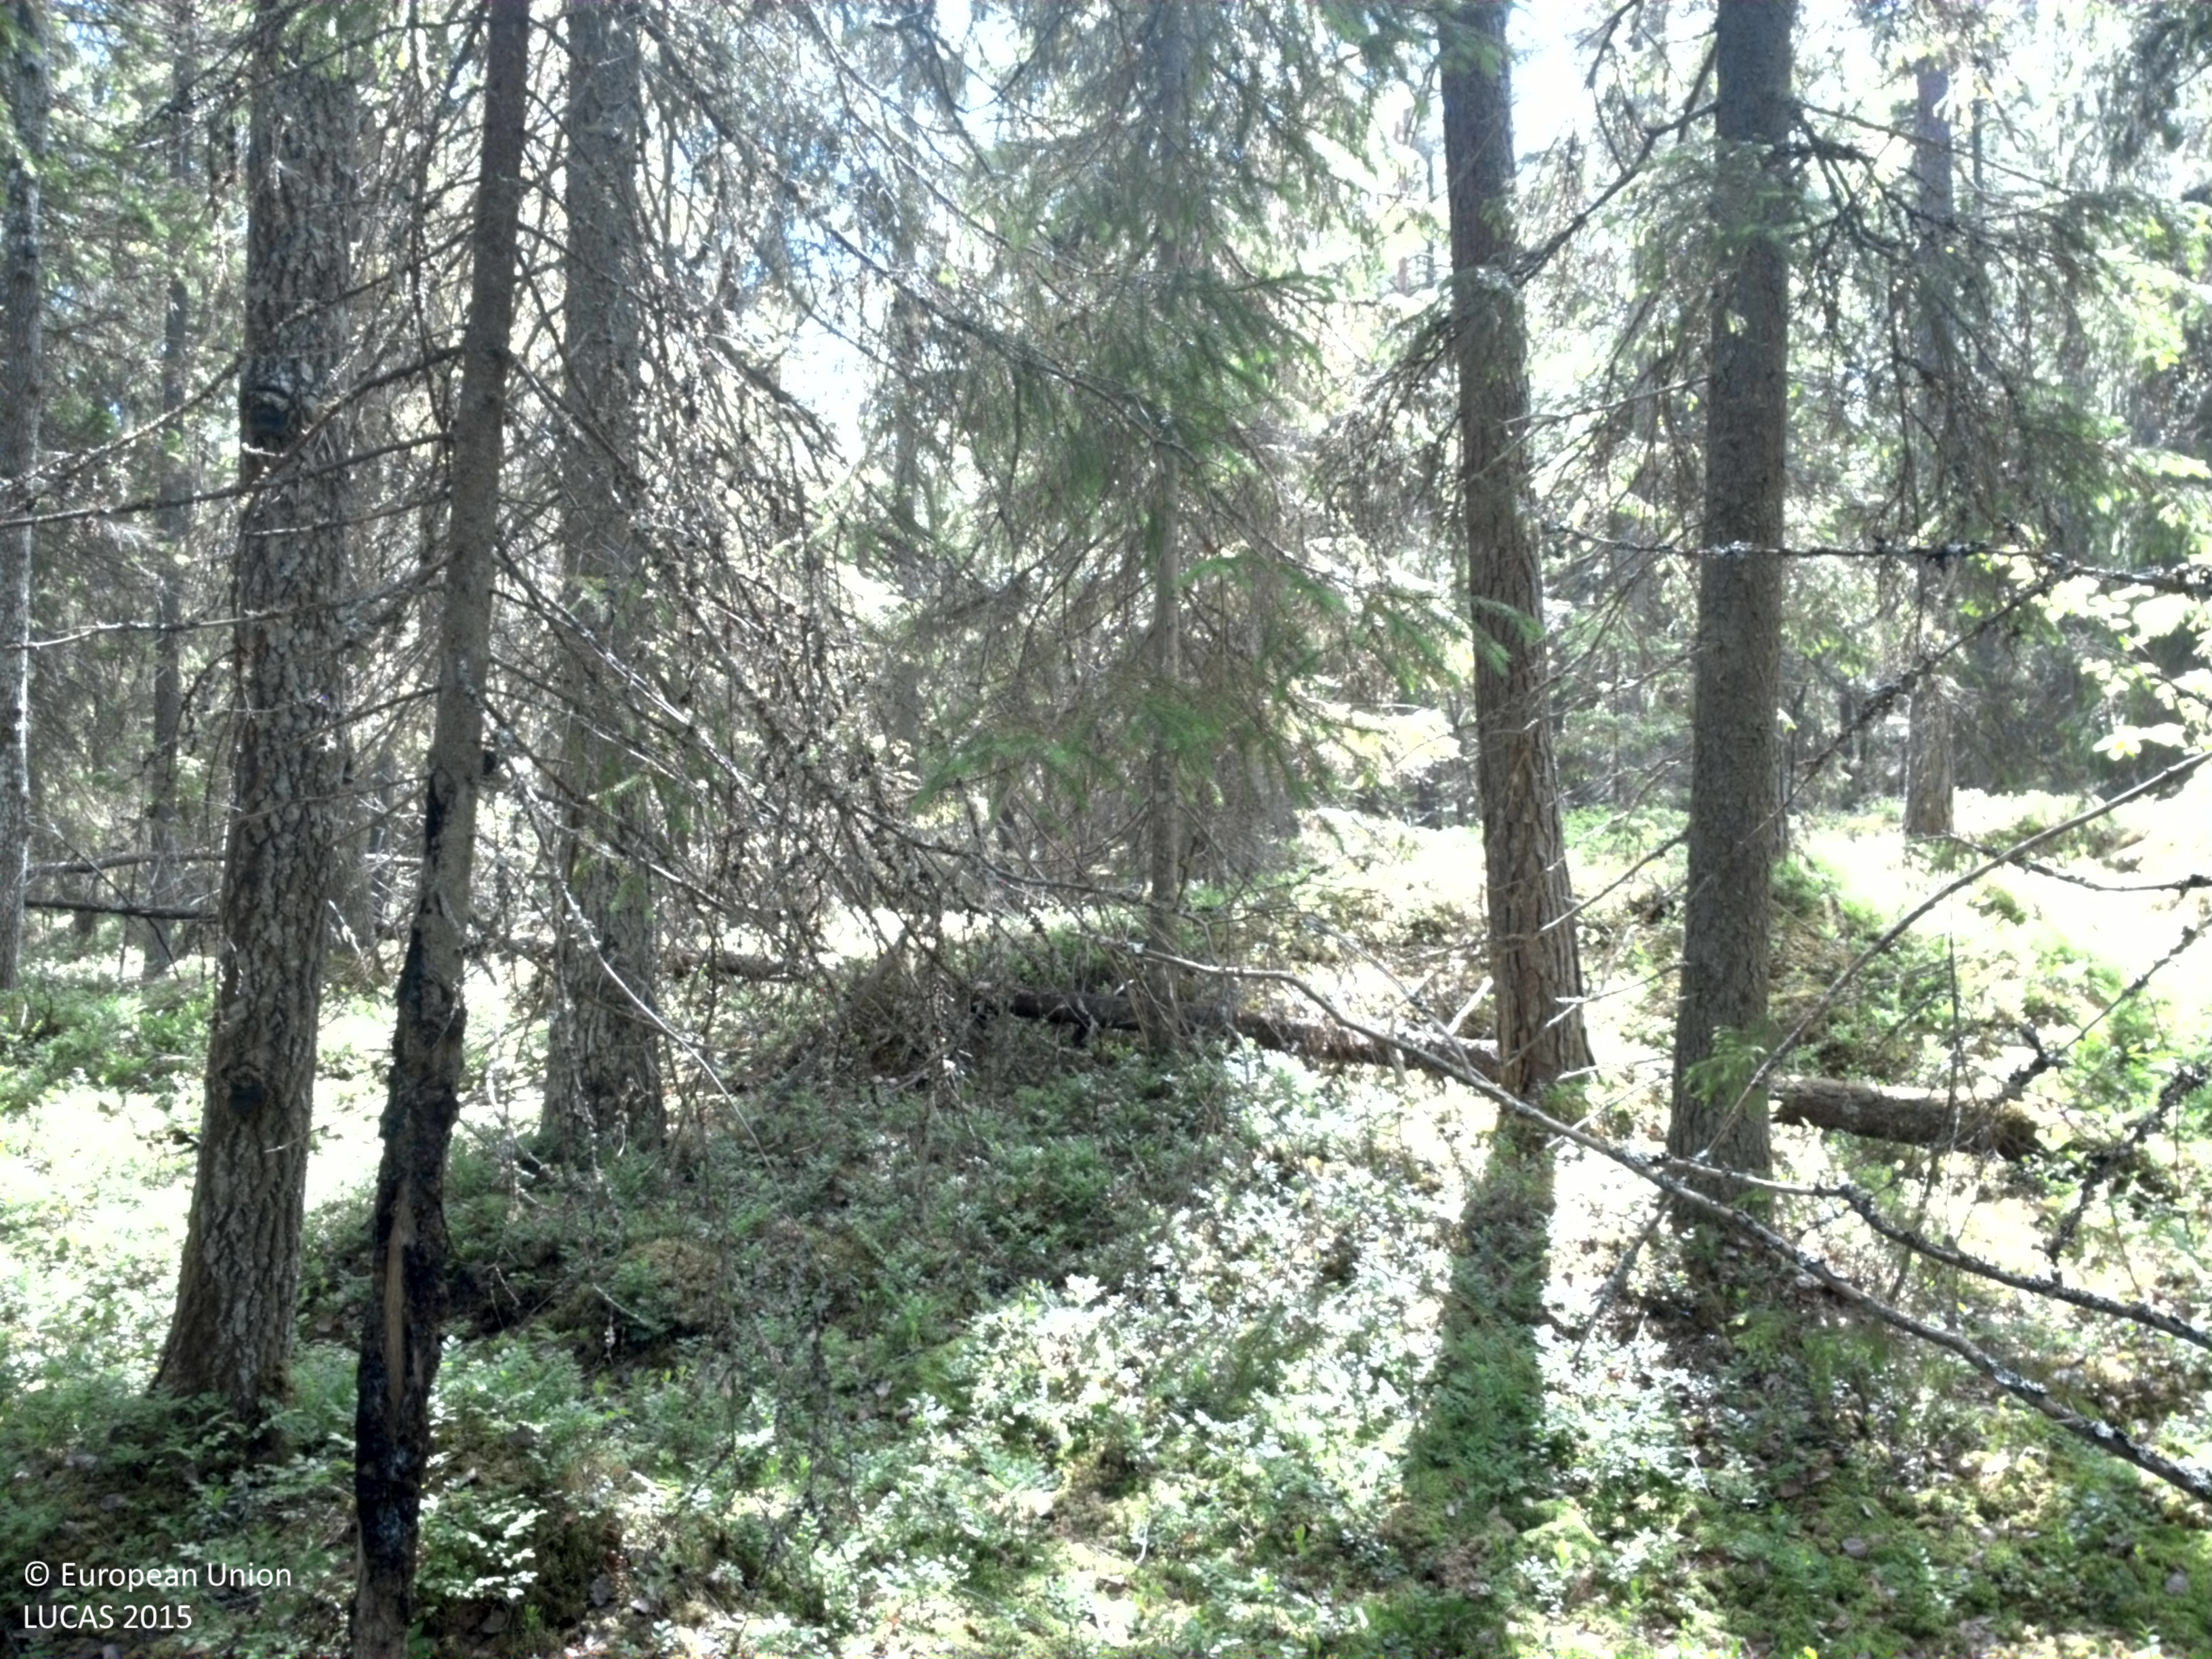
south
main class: Woodland
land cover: Spruce dominated coniferous woodland
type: boreal forest
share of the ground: > 75 %
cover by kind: coniferous forest trees 70 %, broadleaved forest trees 10 %, herbaceous plants 10 %, lichens and mosses 10 %
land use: Forestry
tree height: > 5 m
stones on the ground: < 10 %
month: June
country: SE
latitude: 60.0783
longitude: 18.6428
